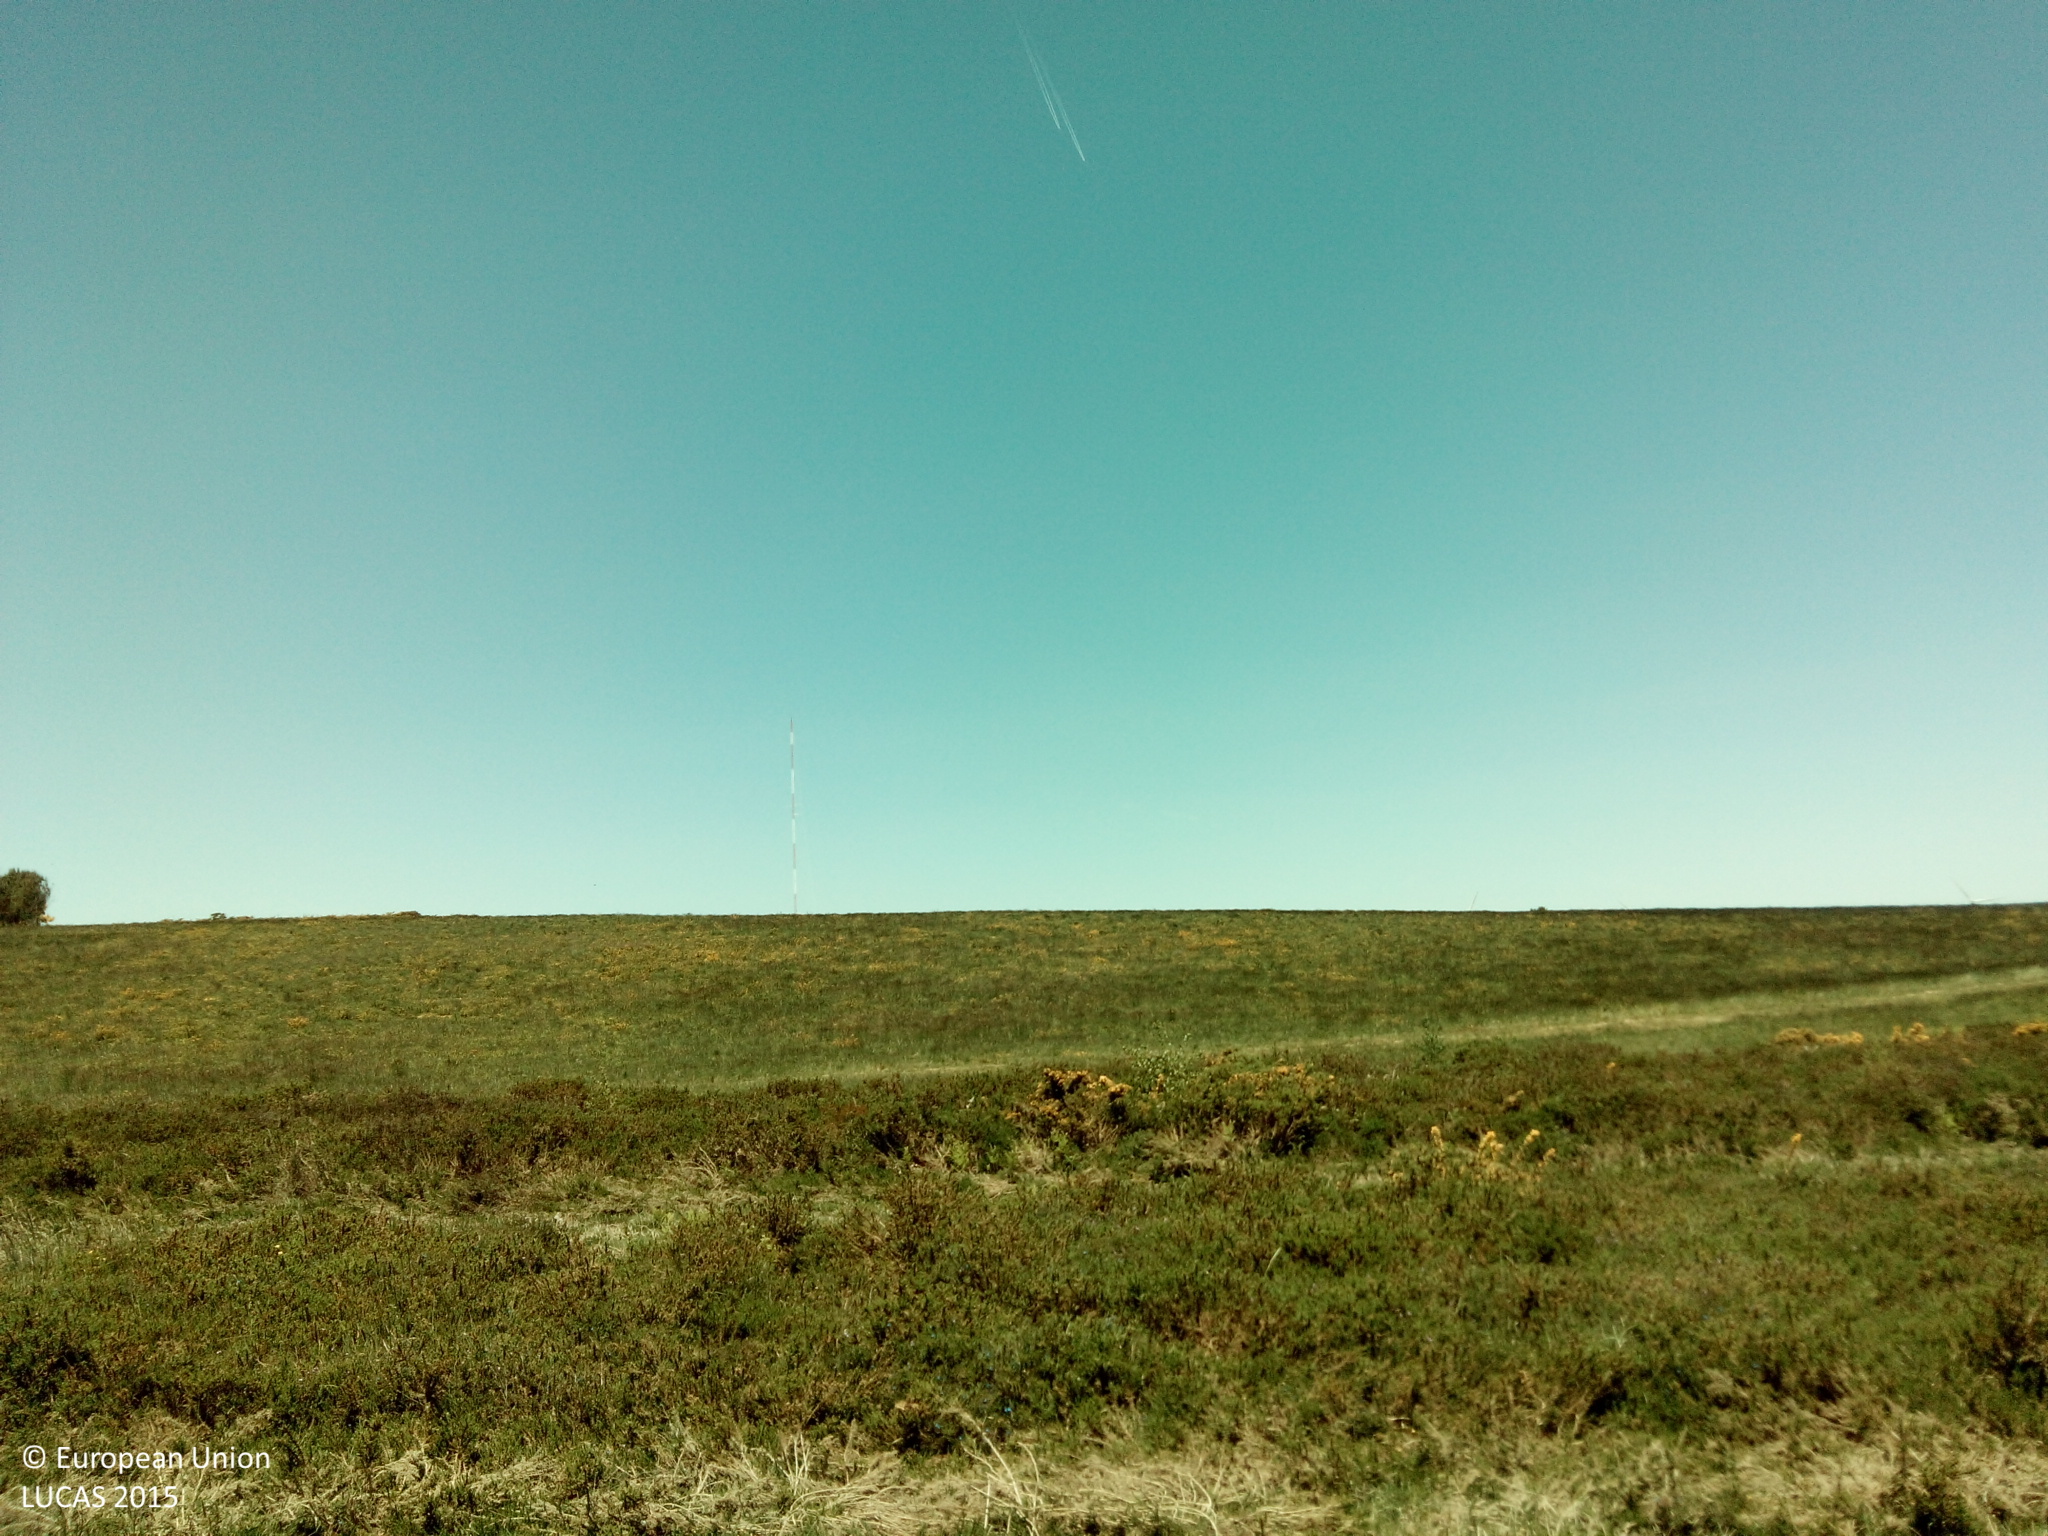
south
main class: Shrubland
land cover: Shrubland without tree cover
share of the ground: > 75 %
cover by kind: shrubs 100 %
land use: Semi-natural and natural areas not in use
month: May
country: ES
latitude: 42.6757
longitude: -8.3639
